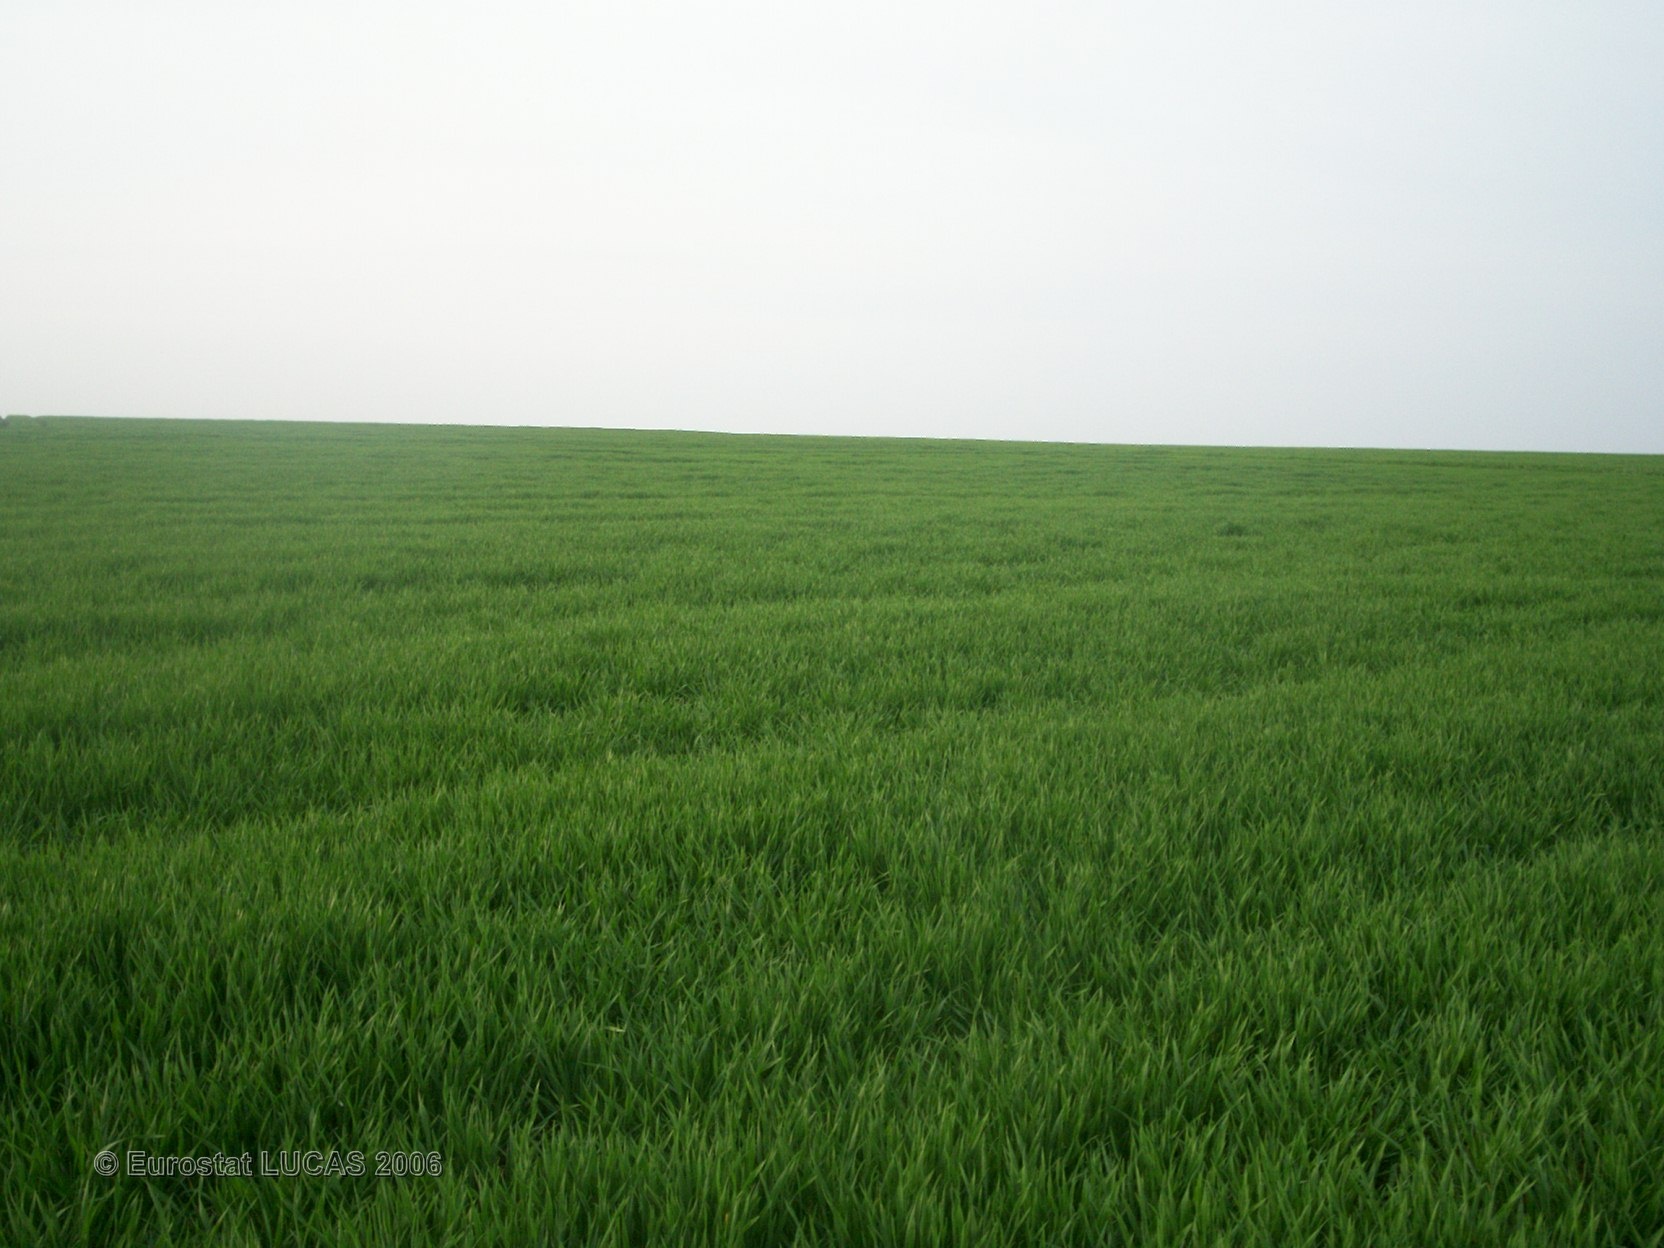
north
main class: Cropland
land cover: Common wheat
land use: Agriculture (excluding fallow land and kitchen gardens)
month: May
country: FR
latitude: 49.1362
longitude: 6.9712
